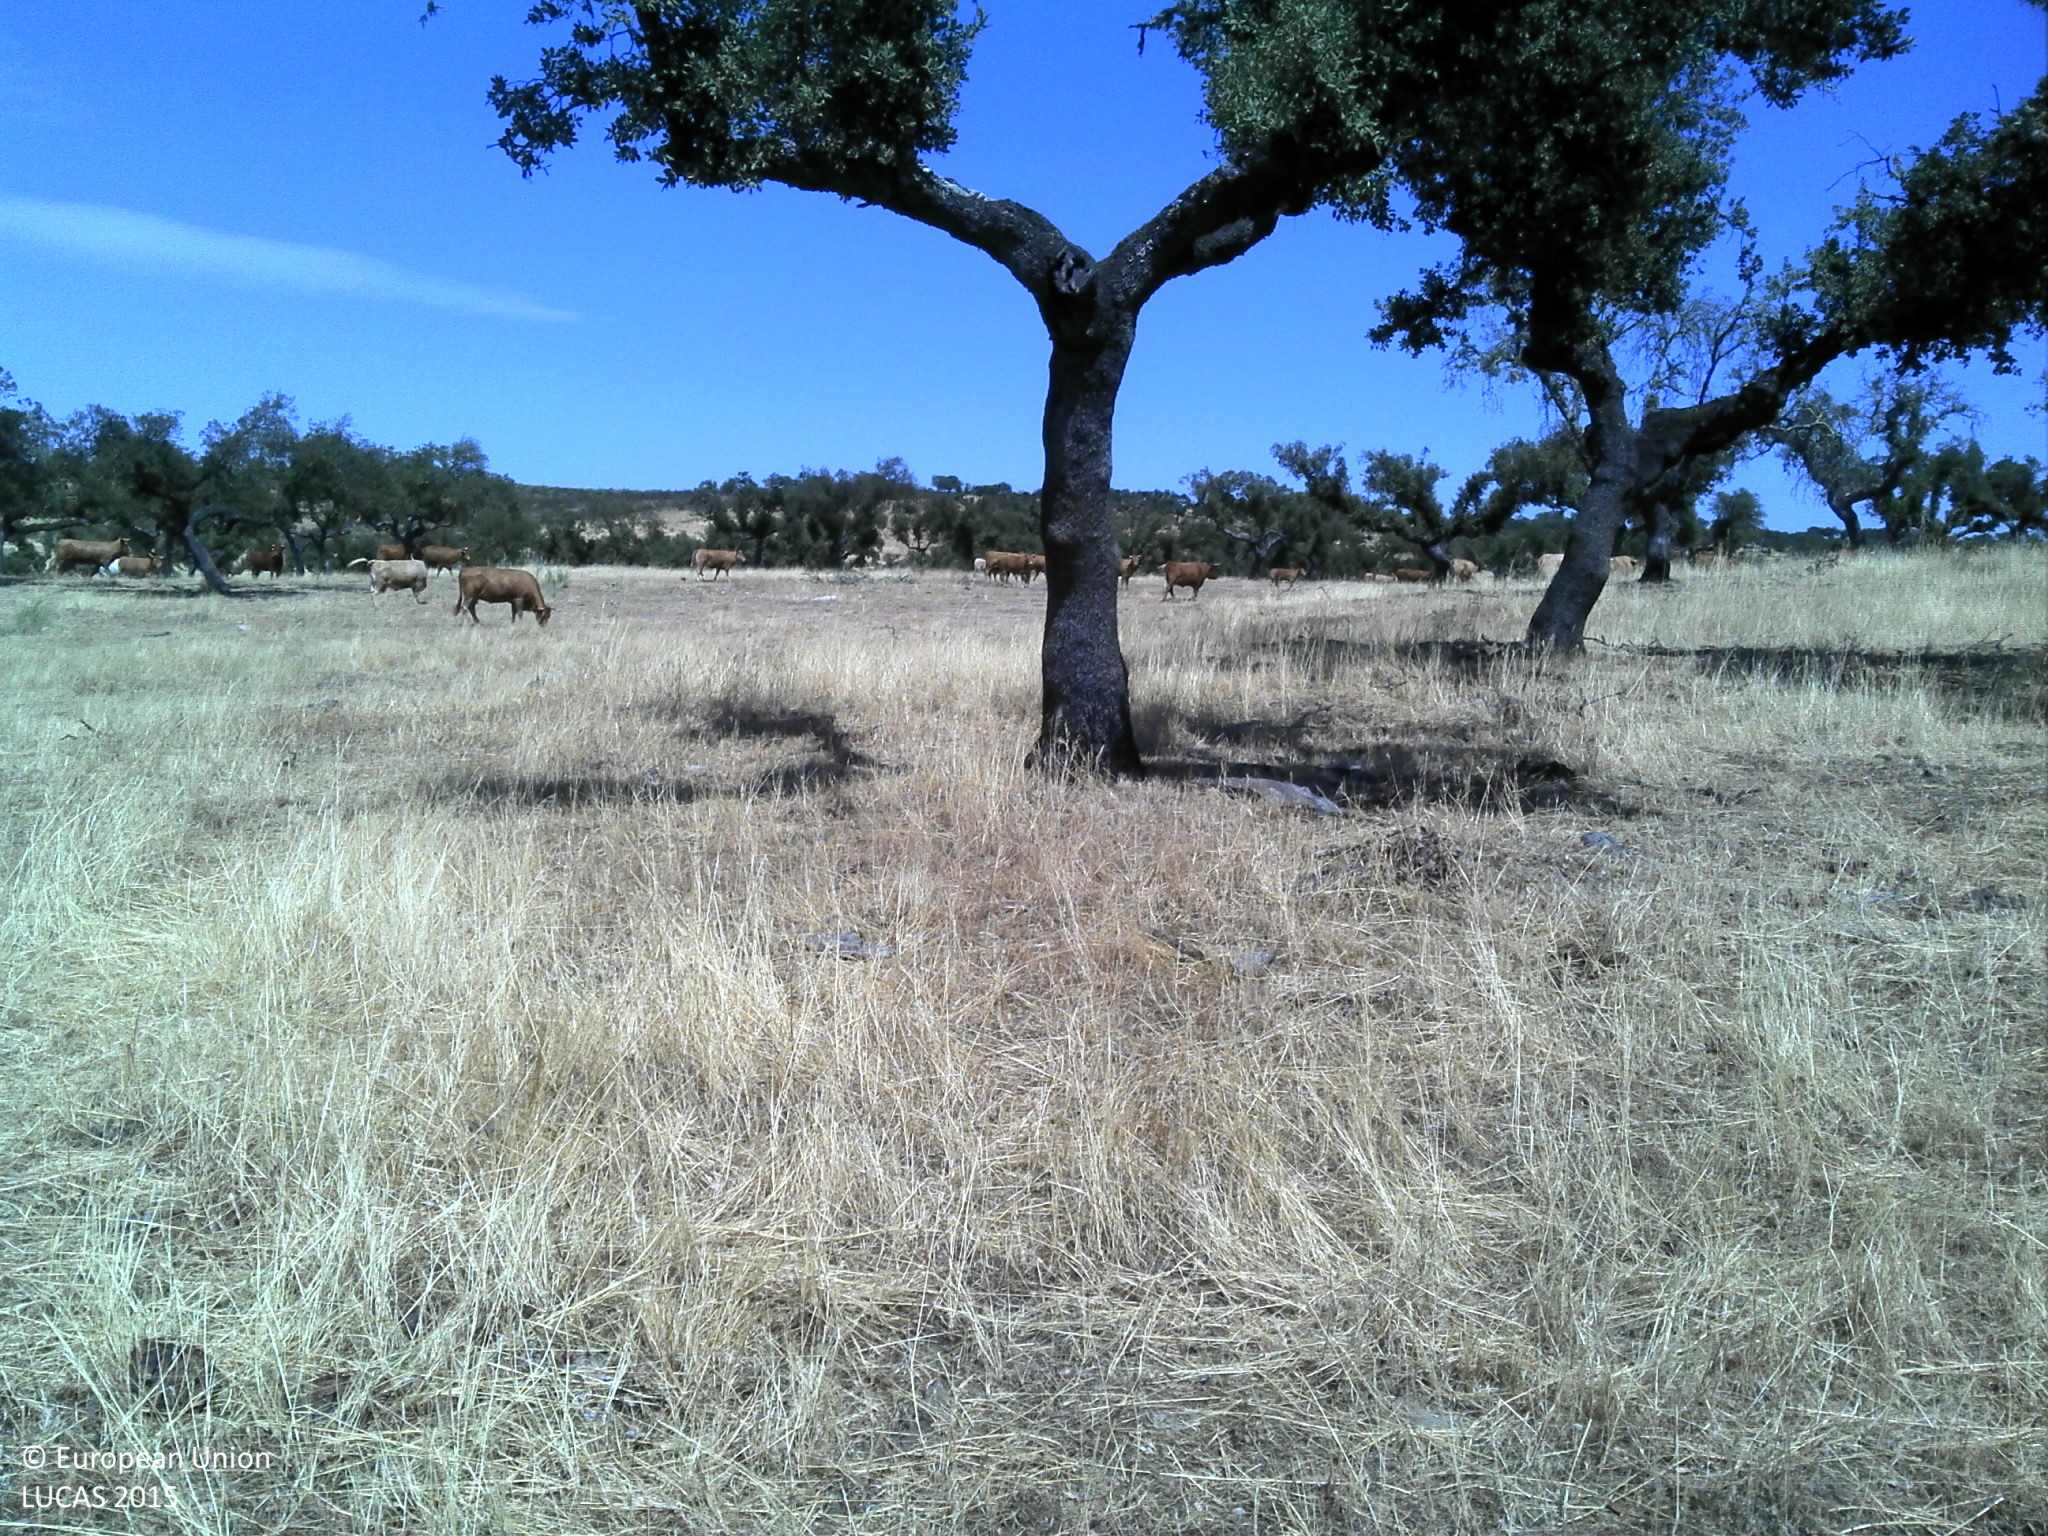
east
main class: Woodland
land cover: Broadleaved woodland
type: broadleaved evergreen forest
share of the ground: 50 - 75 %
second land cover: Grassland without tree/shrub cover
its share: 50 - 75 %
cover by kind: broadleaved forest trees 70 %, herbaceous plants 30 %
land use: Forestry
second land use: Agriculture (excluding fallow land and kitchen gardens)
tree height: > 5 m
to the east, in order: Broadleaved woodland; Grassland without tree/shrub cover; Grassland with sparse tree/shrub cover; Tracks; Grassland with sparse tree/shrub cover; Broadleaved woodland
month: July
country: PT
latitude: 38.3272
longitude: -7.2119
